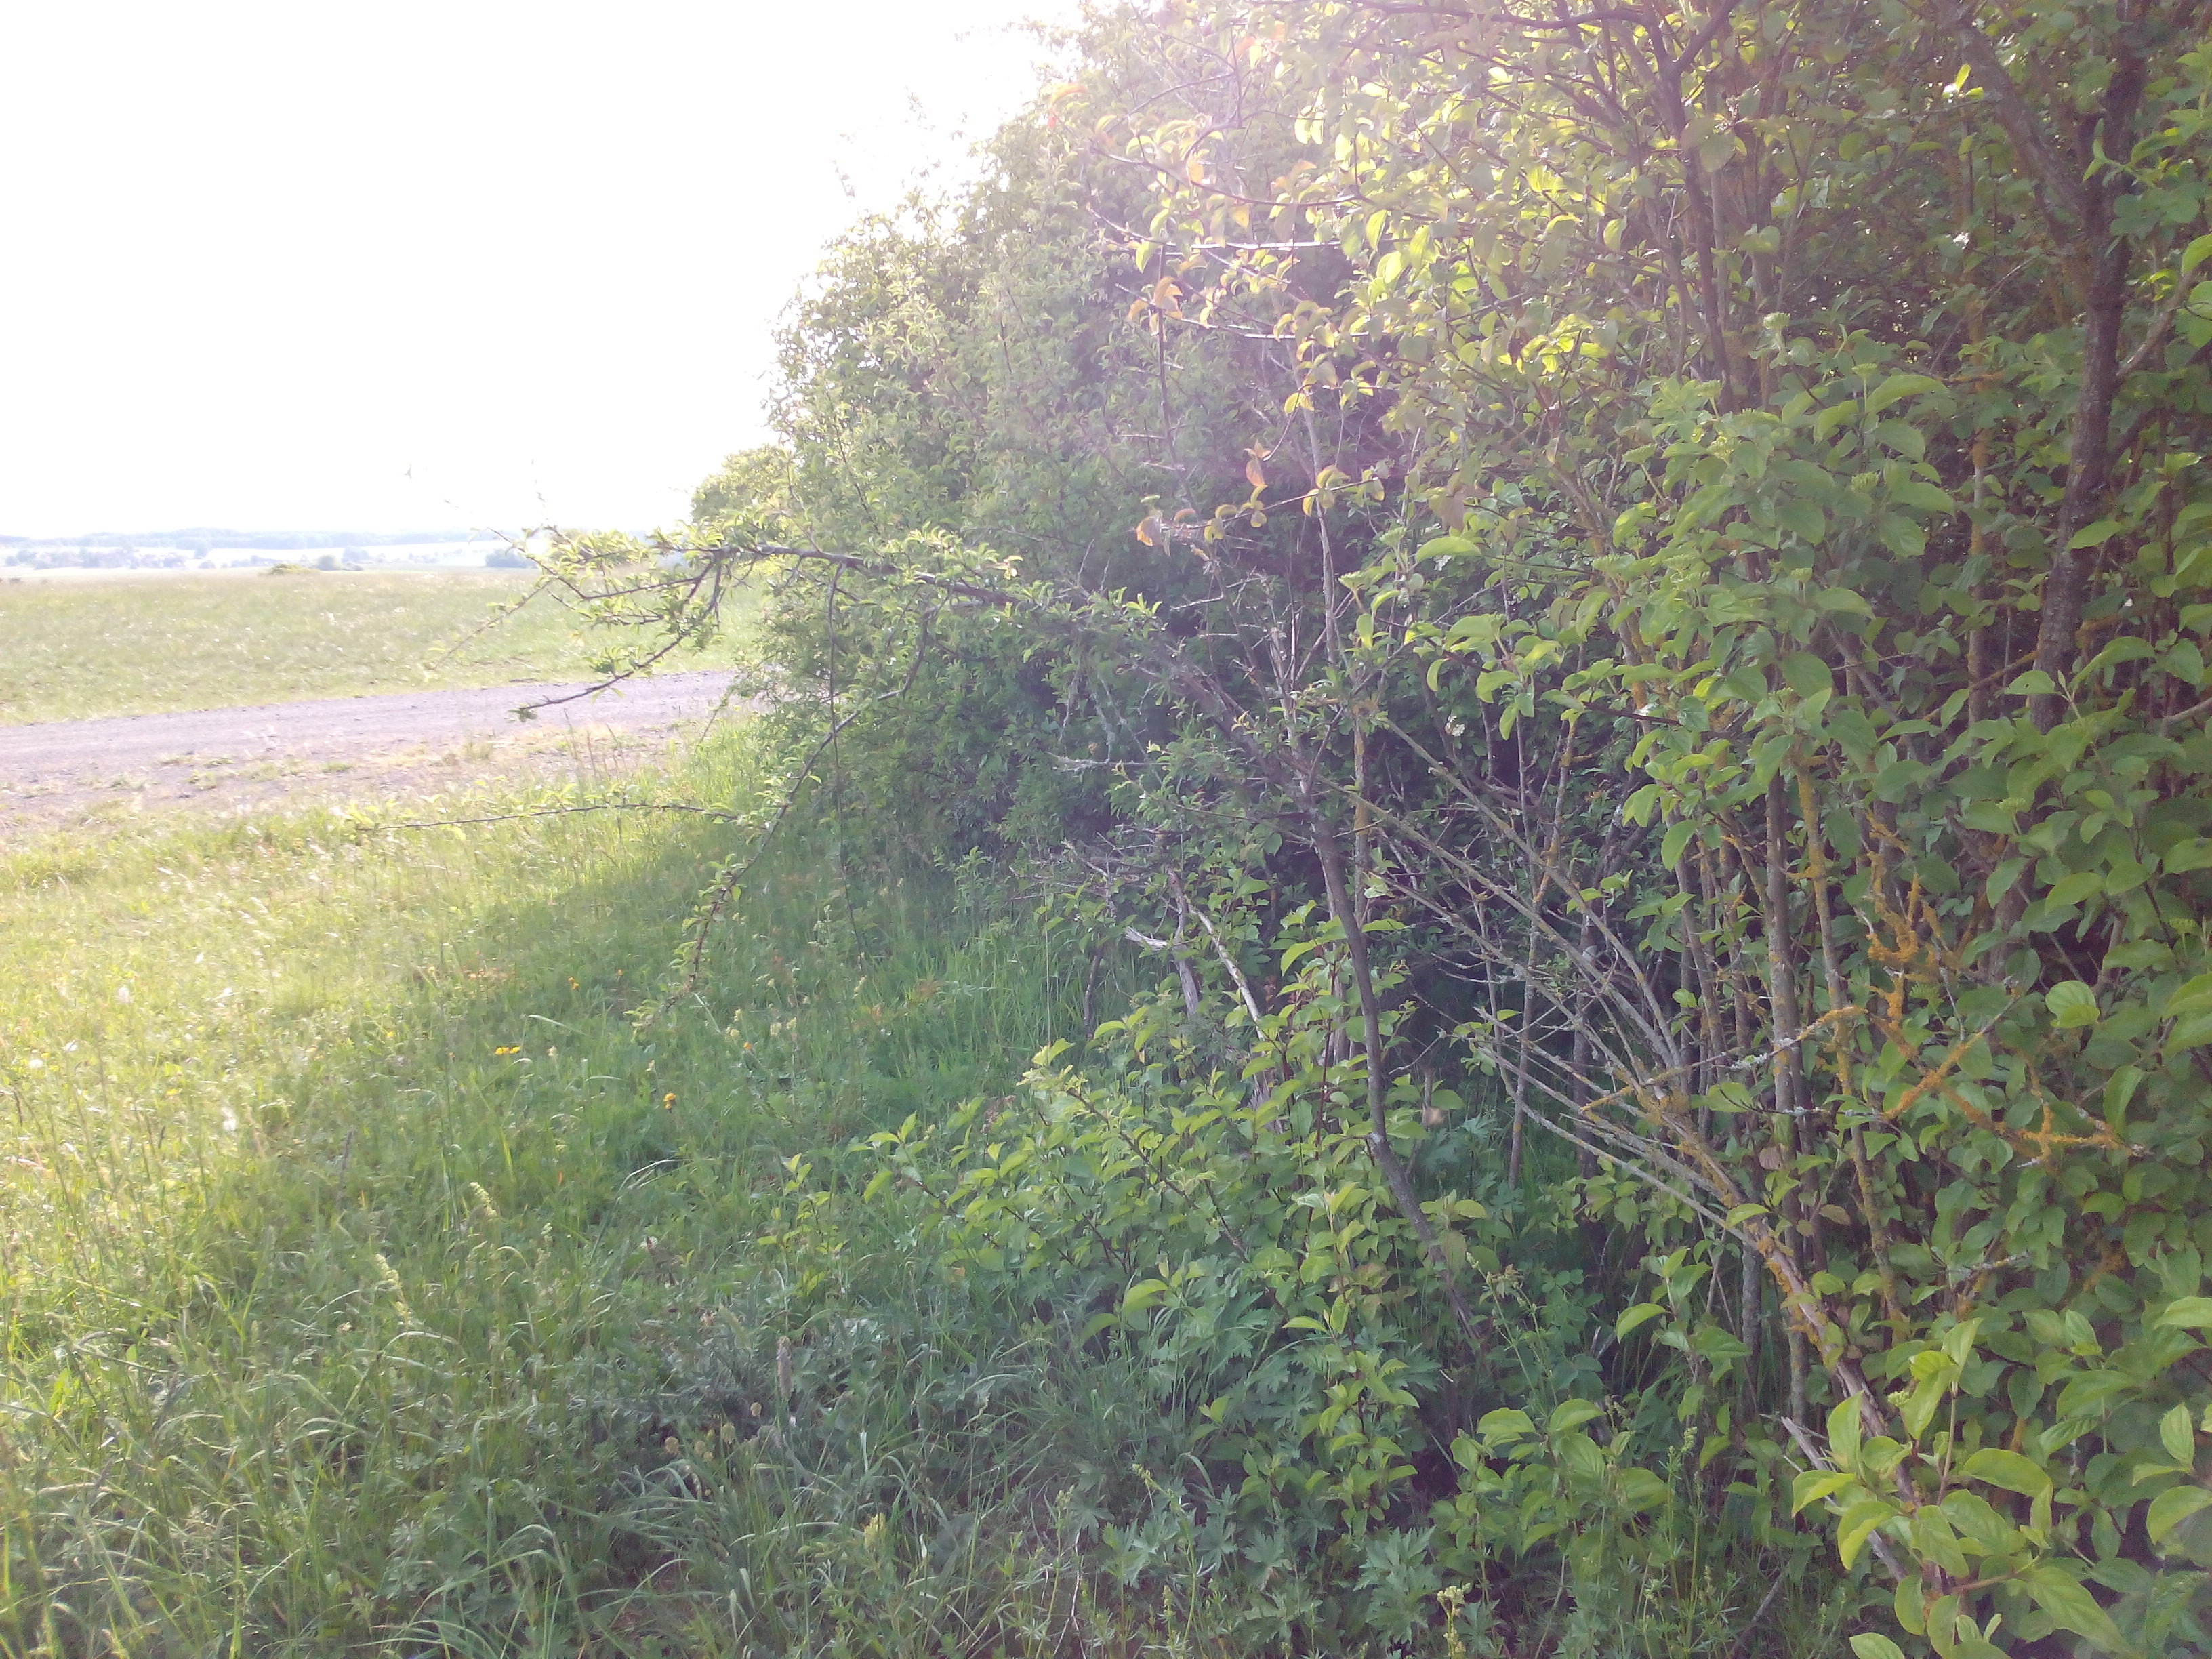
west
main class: Shrubland
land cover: Shrubland with sparse tree cover
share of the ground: > 75 %
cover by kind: shrubs 95 %, broadleaved forest trees 5 %
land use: Semi-natural and natural areas not in use
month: May
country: DE
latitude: 50.3970
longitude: 10.8297
